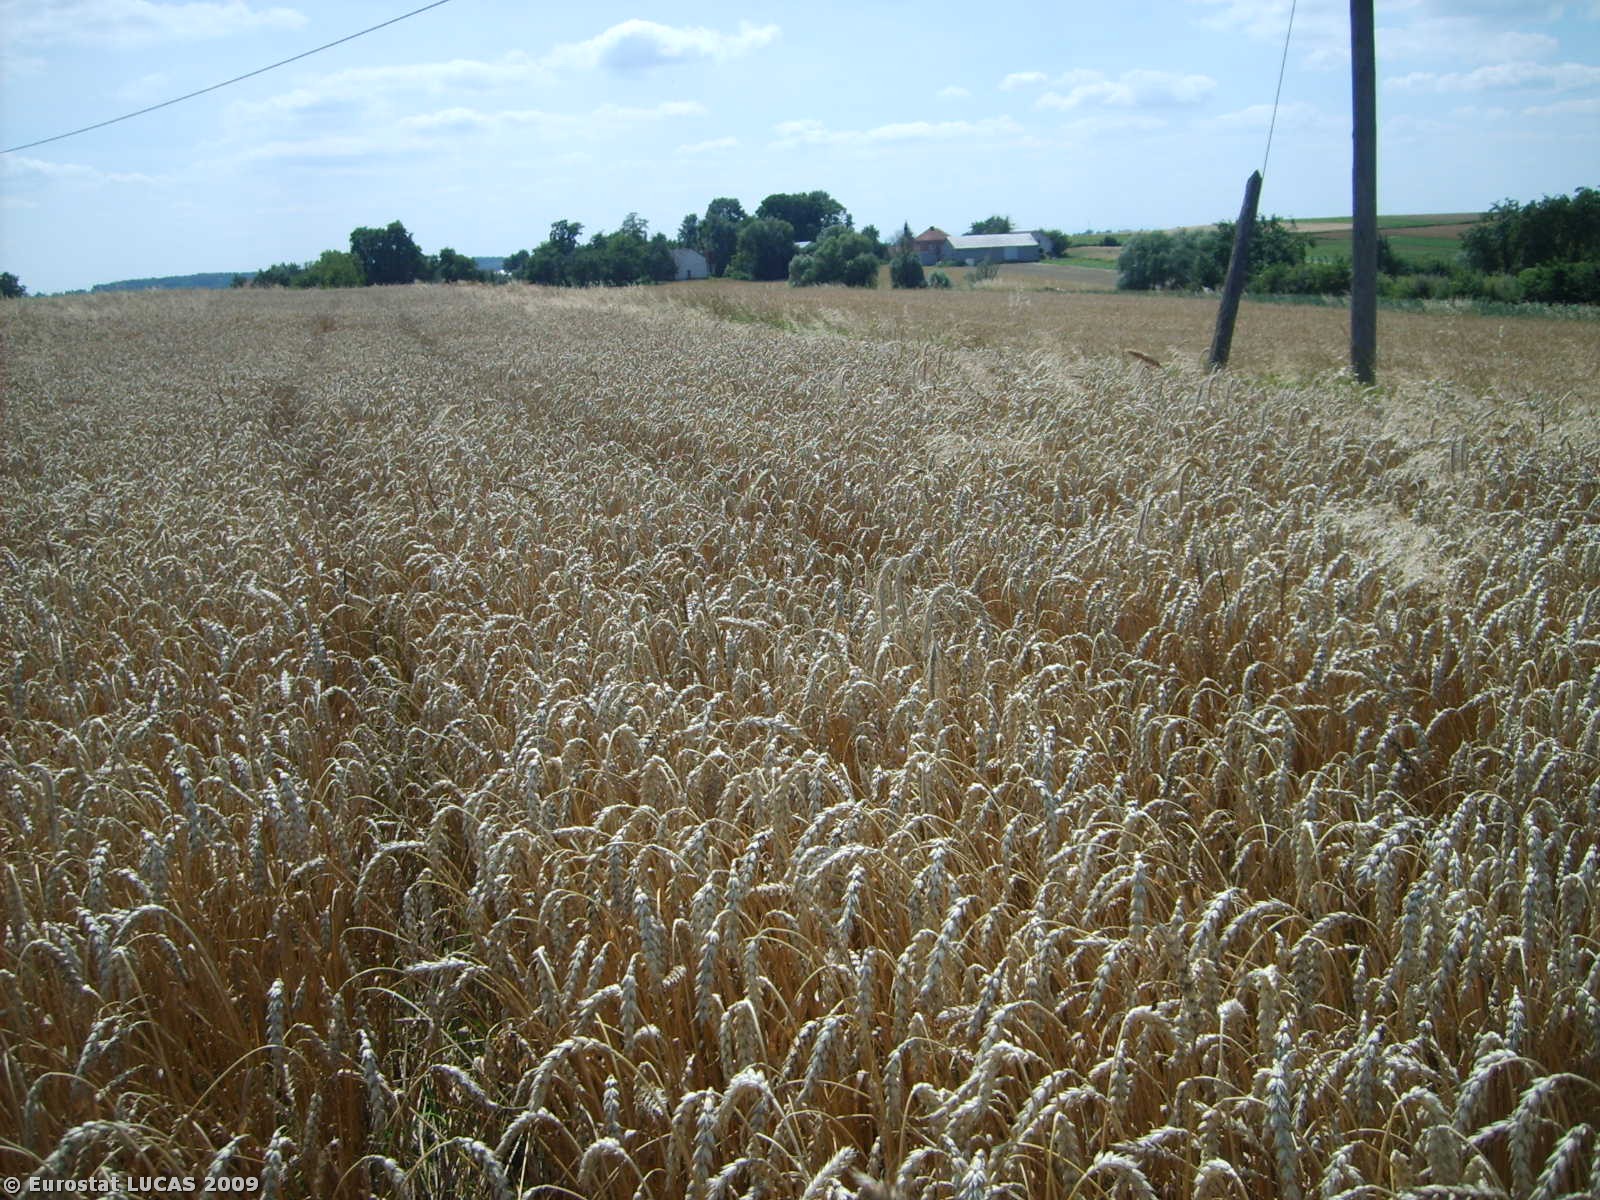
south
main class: Cropland
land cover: Common wheat
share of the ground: > 75 %
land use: Agriculture (excluding fallow land and kitchen gardens)
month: July
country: PL
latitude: 50.2715
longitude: 20.3770
